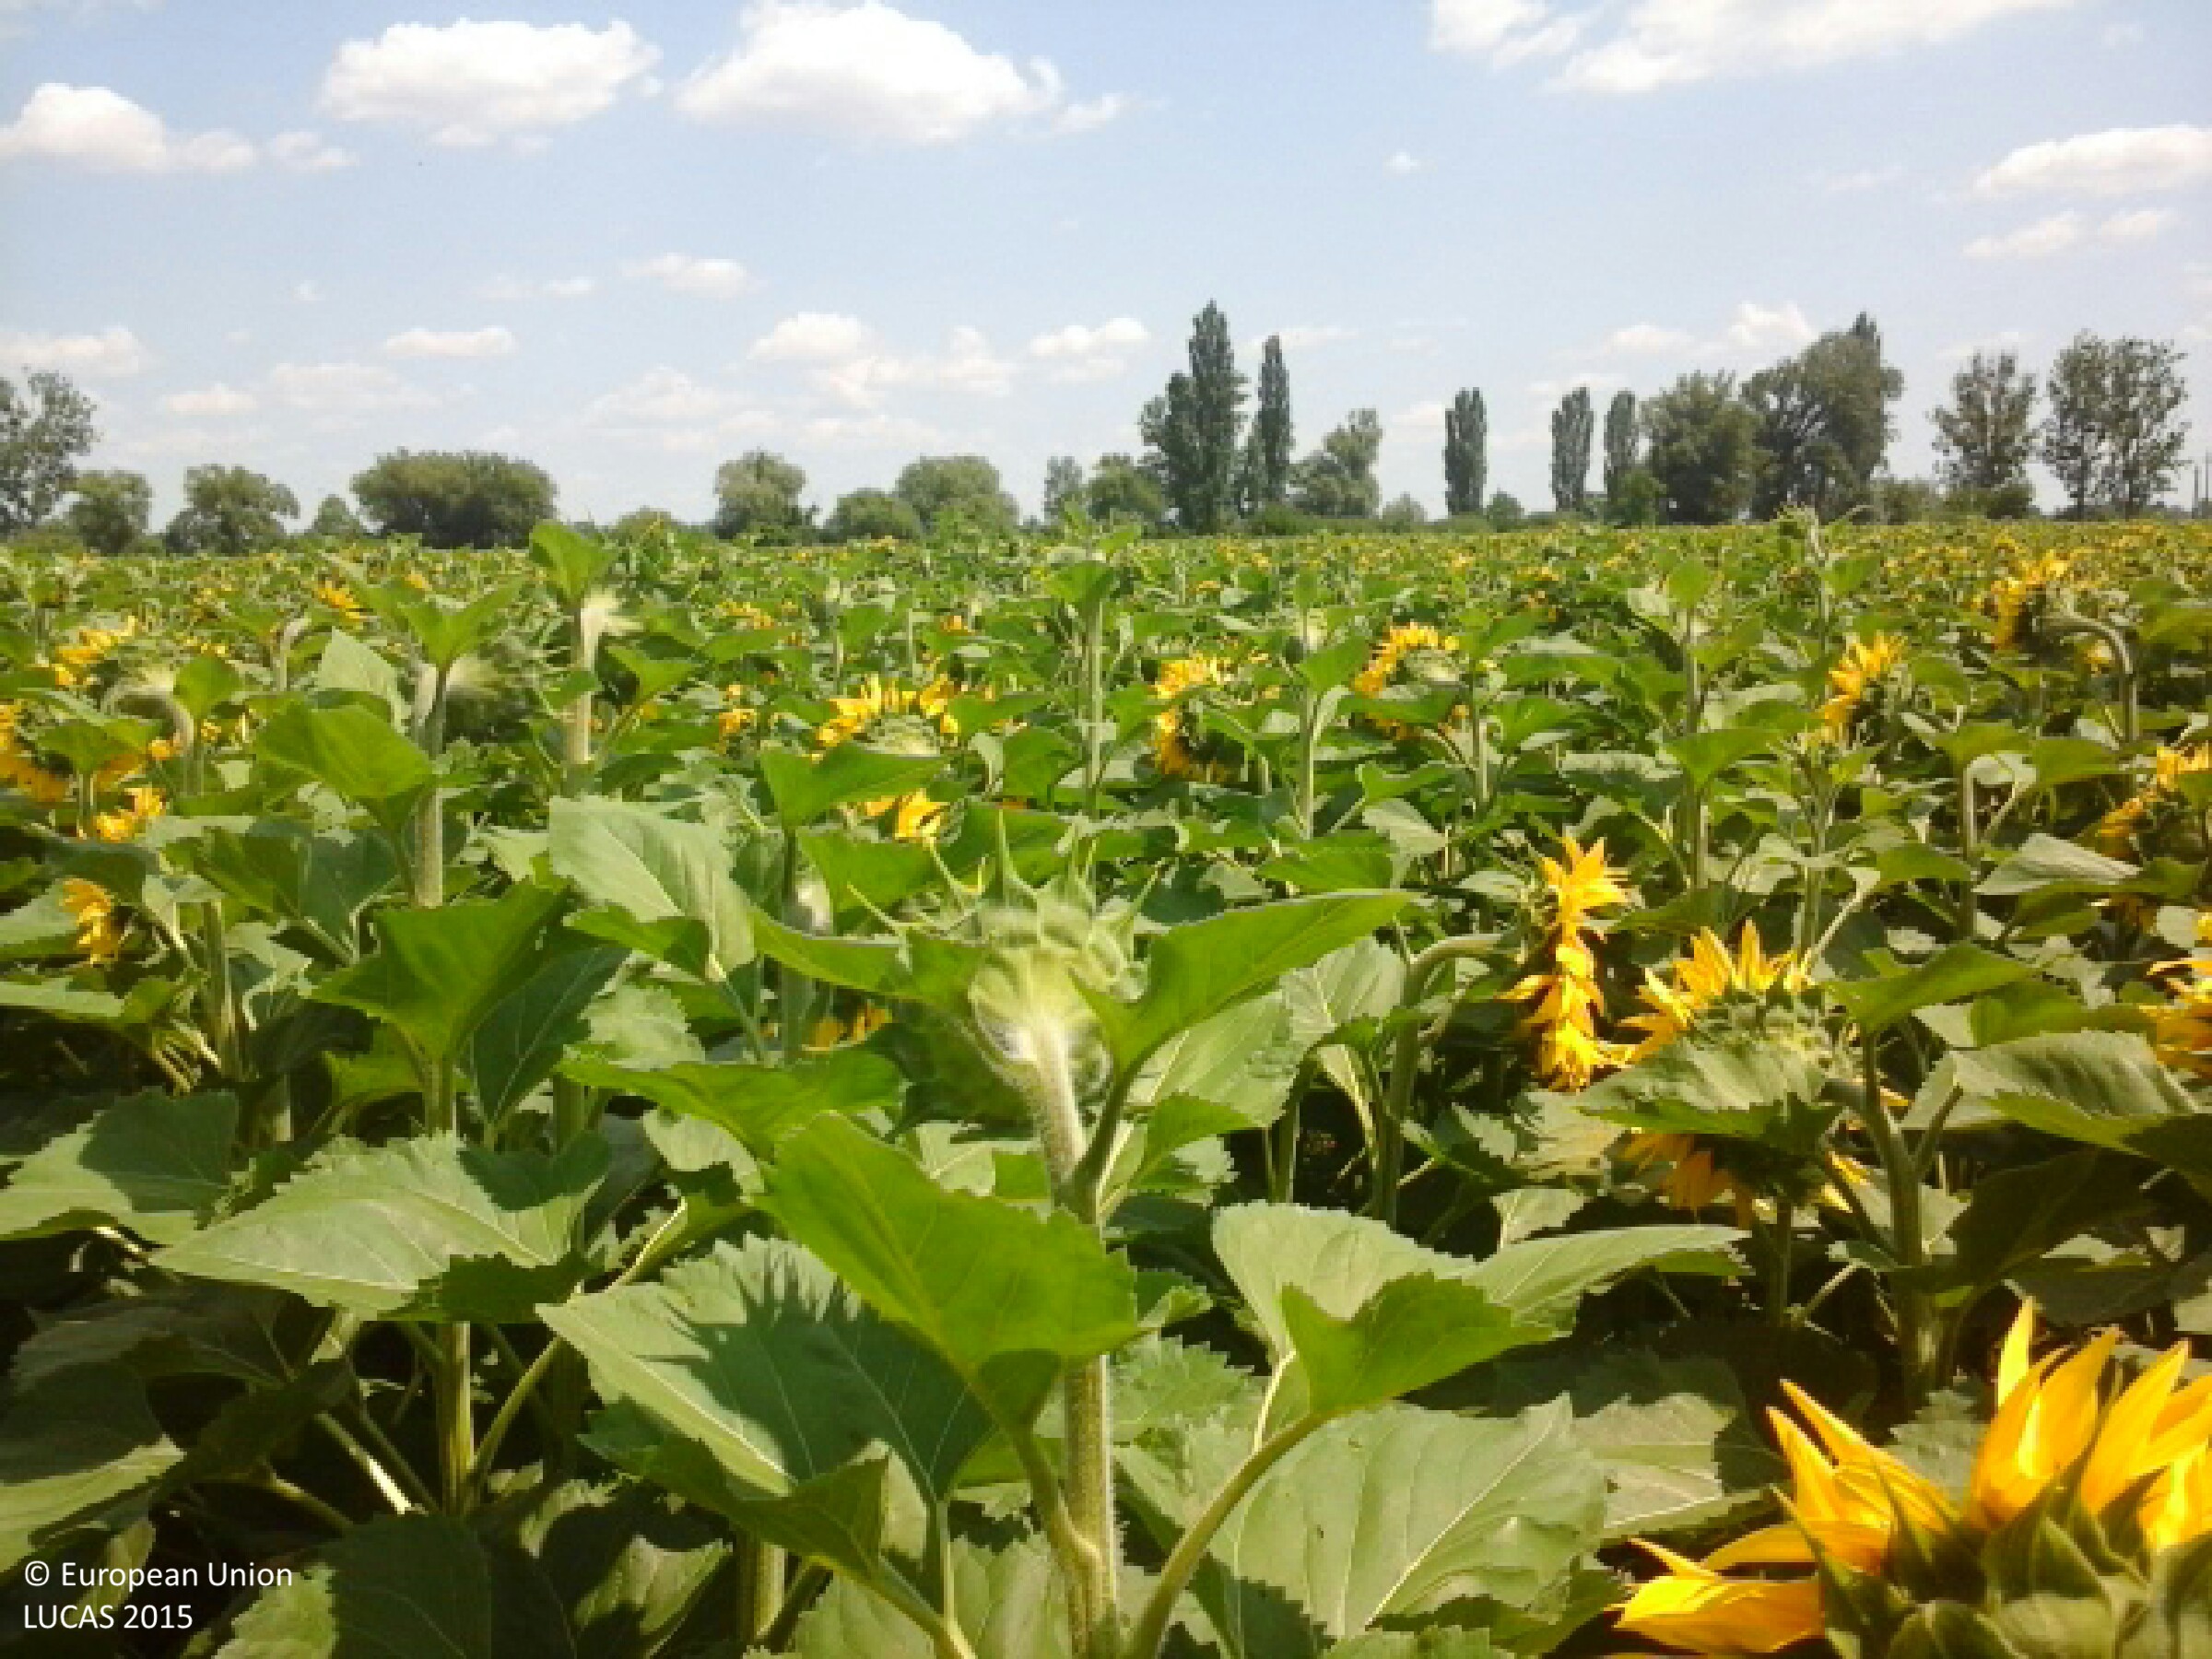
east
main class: Cropland
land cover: Sunflower
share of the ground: > 75 %
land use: Agriculture (excluding fallow land and kitchen gardens)
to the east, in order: Sunflower
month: July
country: HU
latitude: 48.2995
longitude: 21.6006
